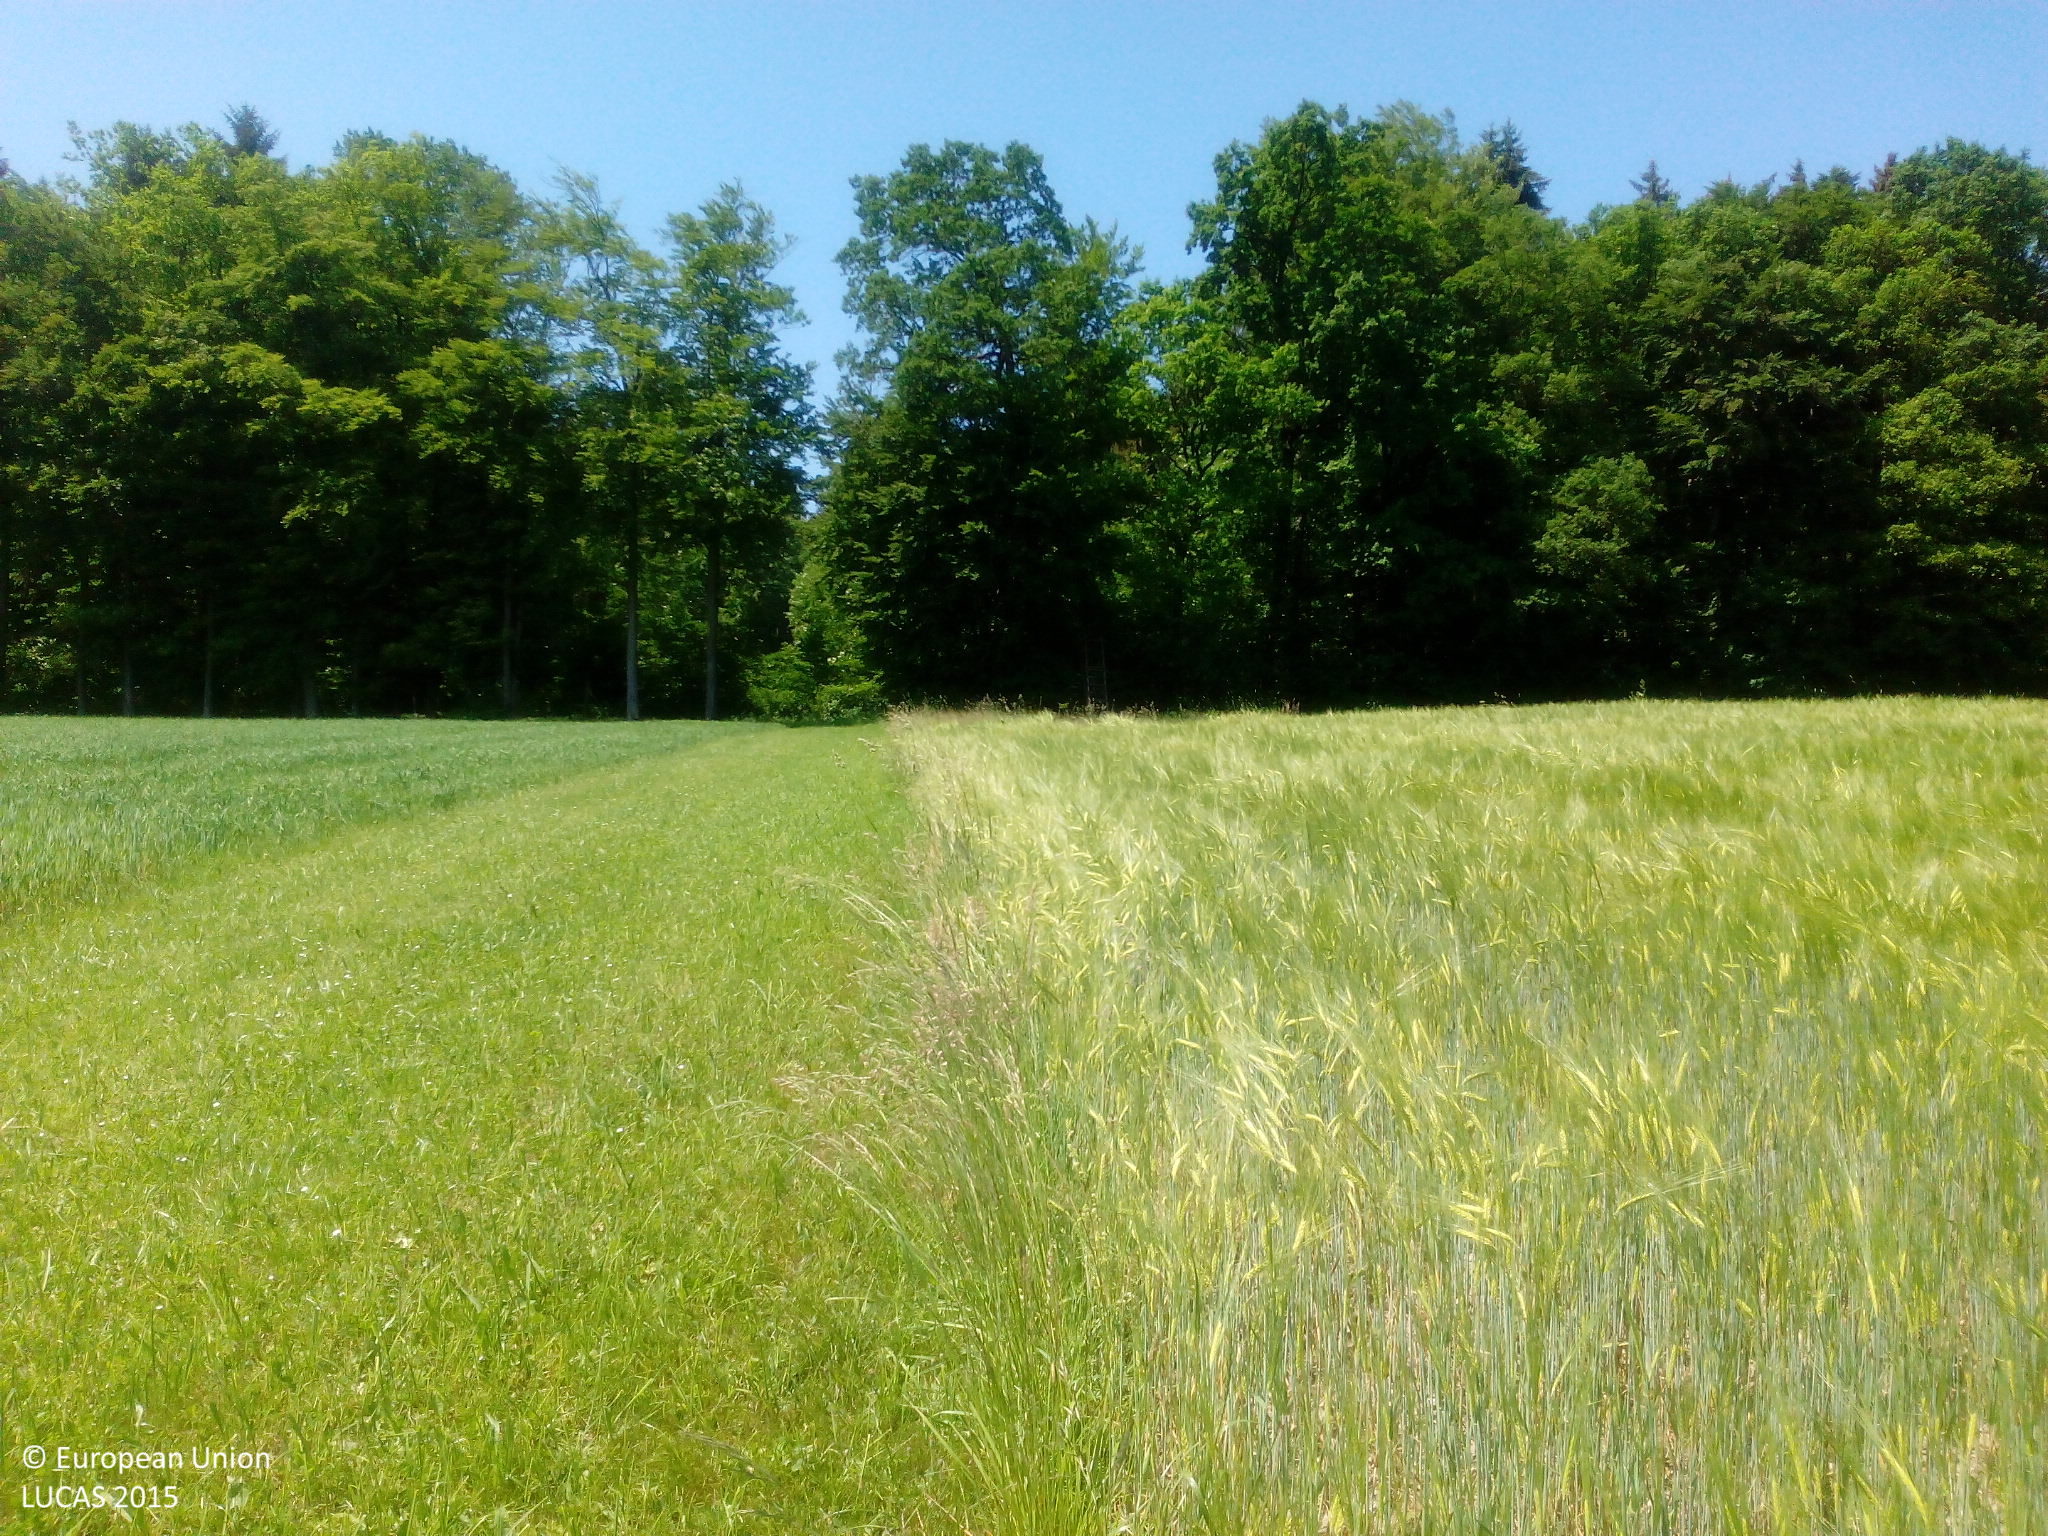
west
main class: Cropland
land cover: Barley
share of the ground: > 75 %
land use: Agriculture (excluding fallow land and kitchen gardens)
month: June
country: DE
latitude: 49.3202
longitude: 12.8750
